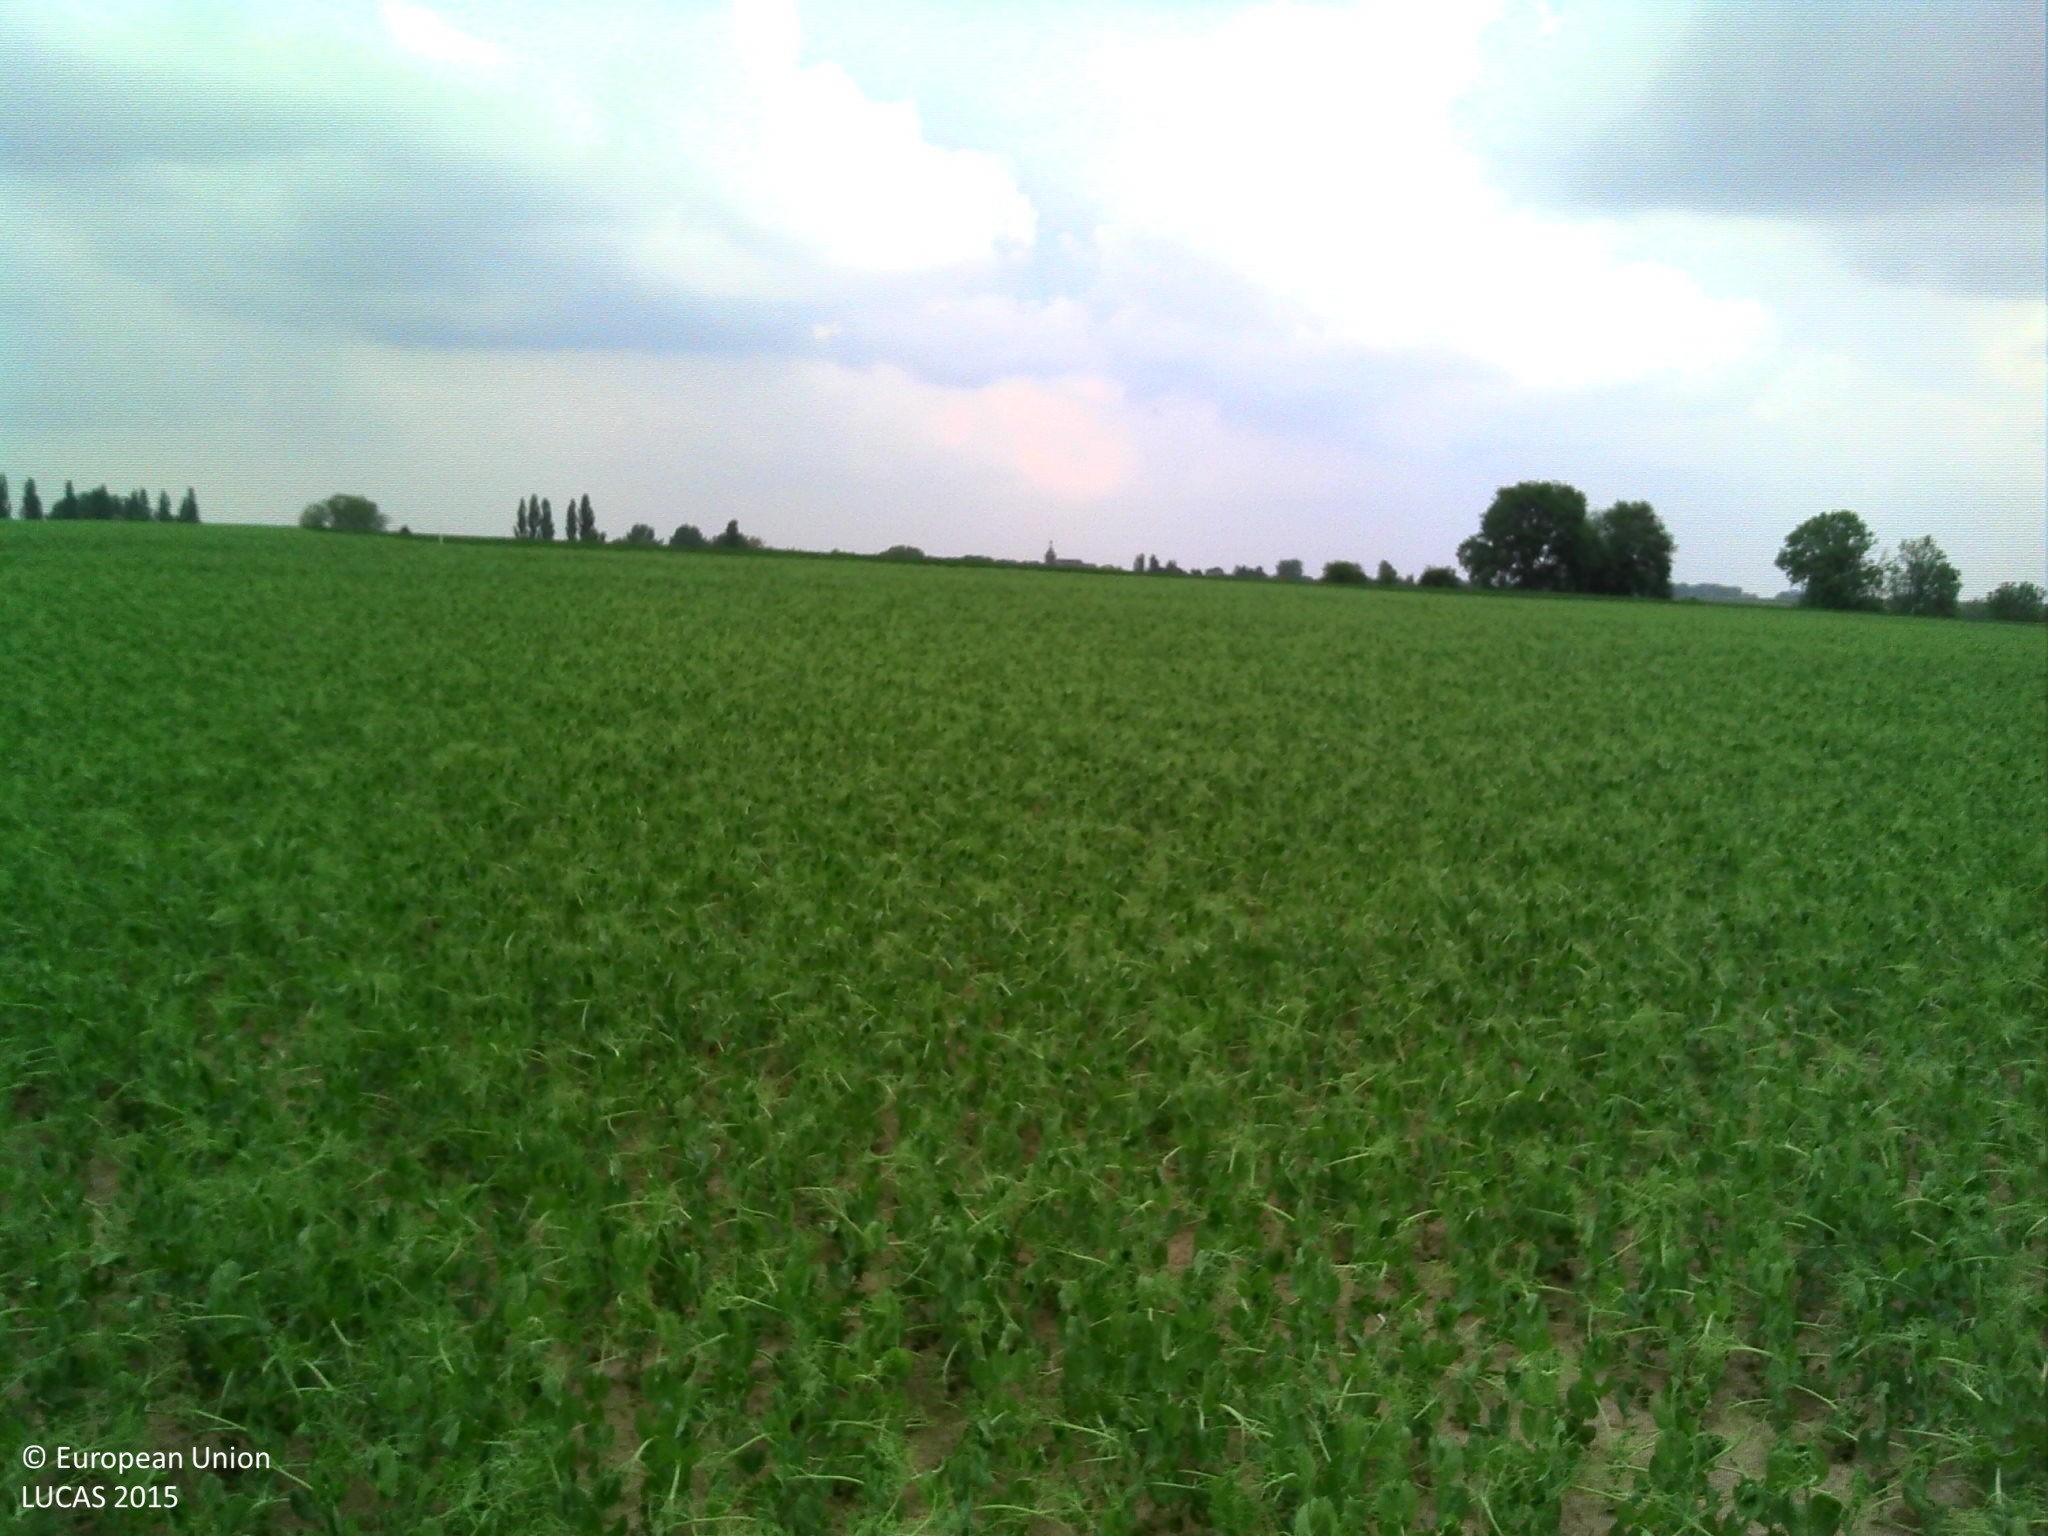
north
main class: Cropland
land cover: Dry pulses
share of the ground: > 75 %
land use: Agriculture (excluding fallow land and kitchen gardens)
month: May
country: BE
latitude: 50.6451
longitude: 4.8633
